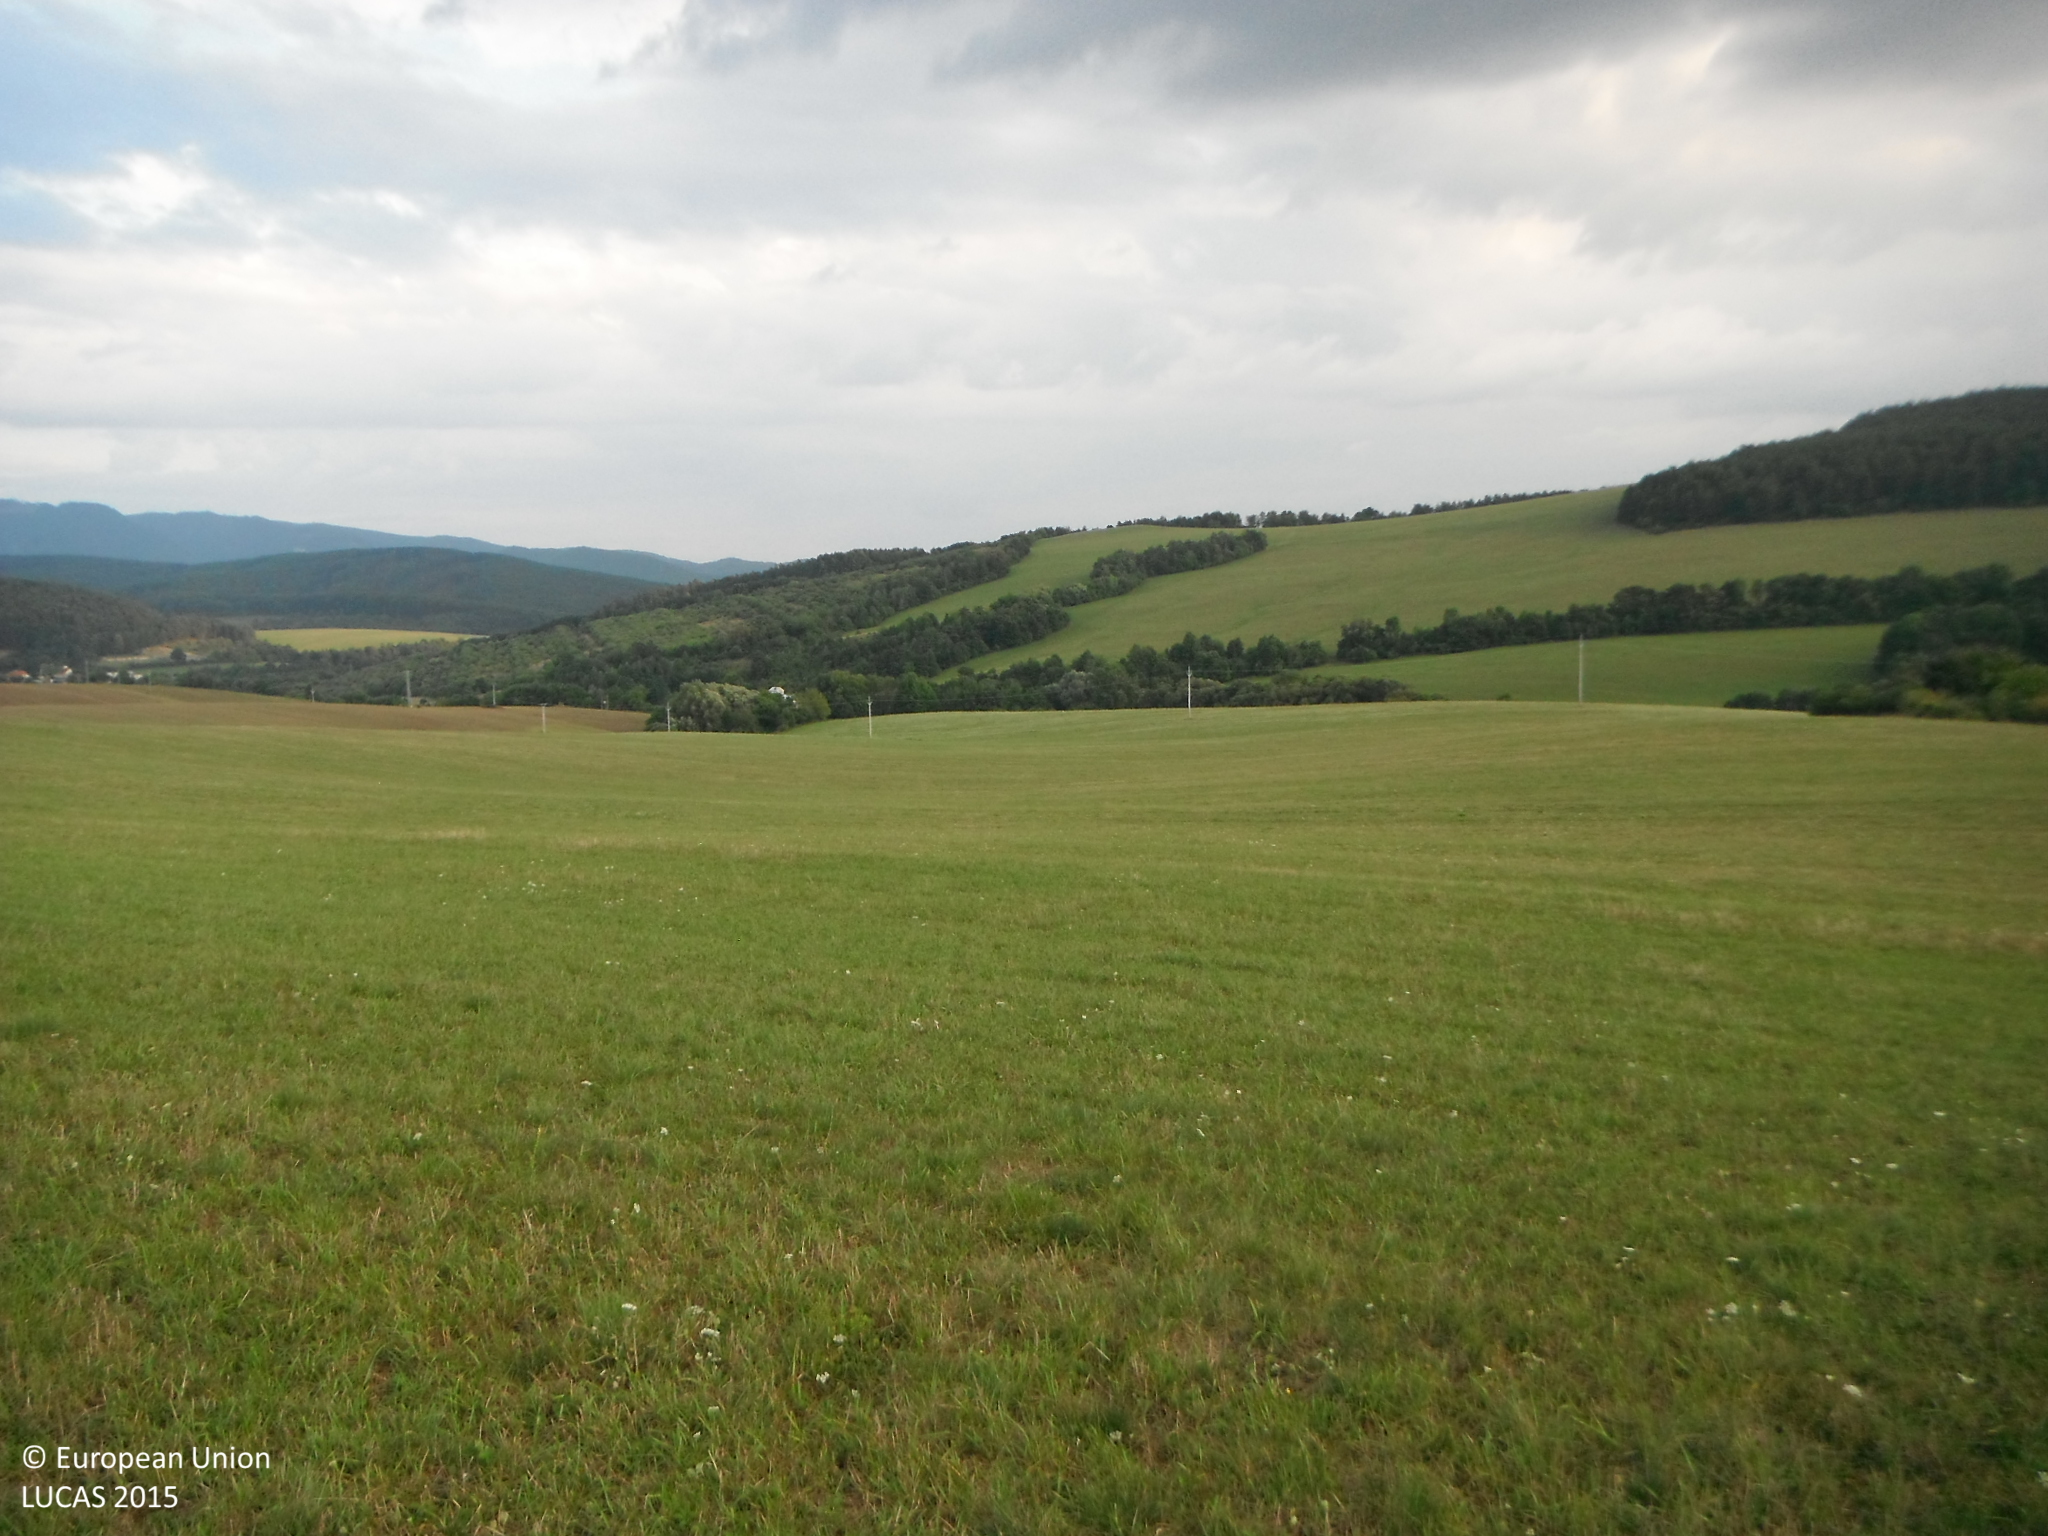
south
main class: Grassland
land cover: Grassland without tree/shrub cover
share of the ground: > 75 %
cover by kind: herbaceous plants 100 %
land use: Agriculture (excluding fallow land and kitchen gardens)
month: August
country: SK
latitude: 48.8117
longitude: 18.3366
